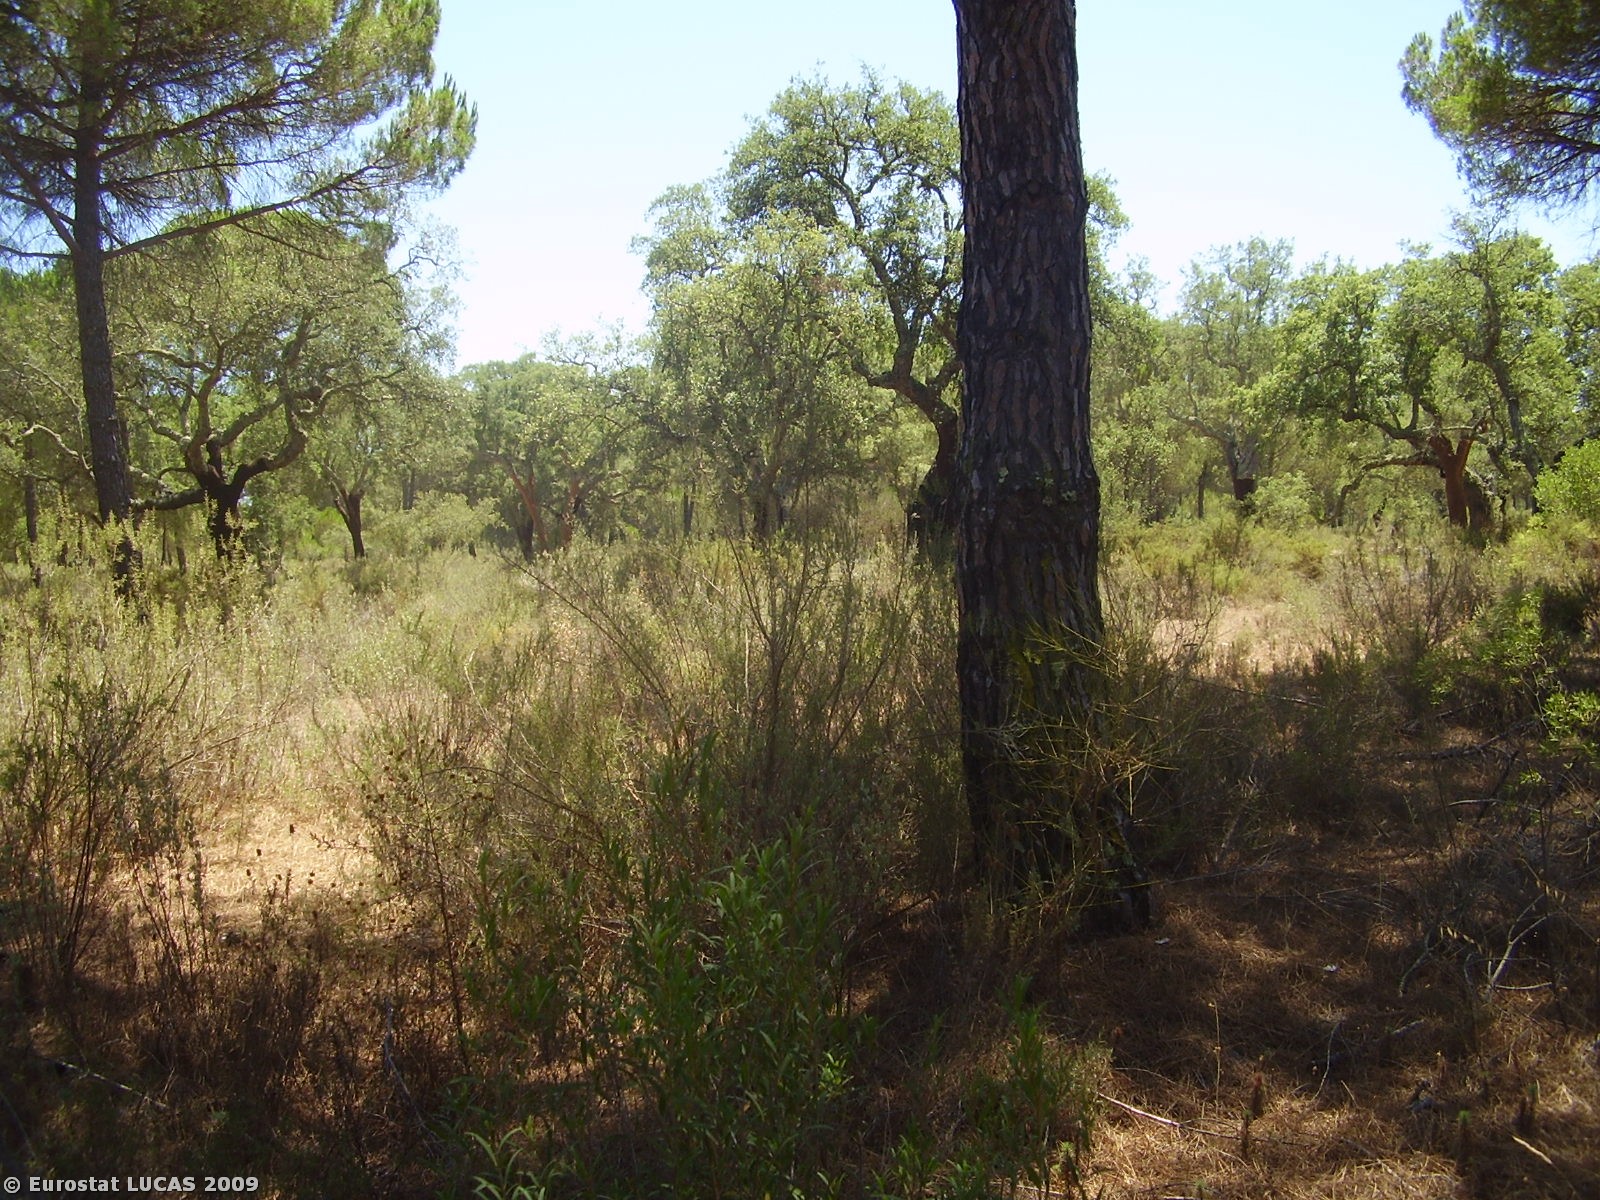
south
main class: Woodland
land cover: Coniferous woodland
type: coniferous forest of the mediterranean region
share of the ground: 10 - 25 %
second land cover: Spontaneously vegetated surfaces
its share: 25 - 50 %
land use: Forestry
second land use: Fallow land
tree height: > 5 m
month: July
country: PT
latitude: 38.1571
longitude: -8.4063
